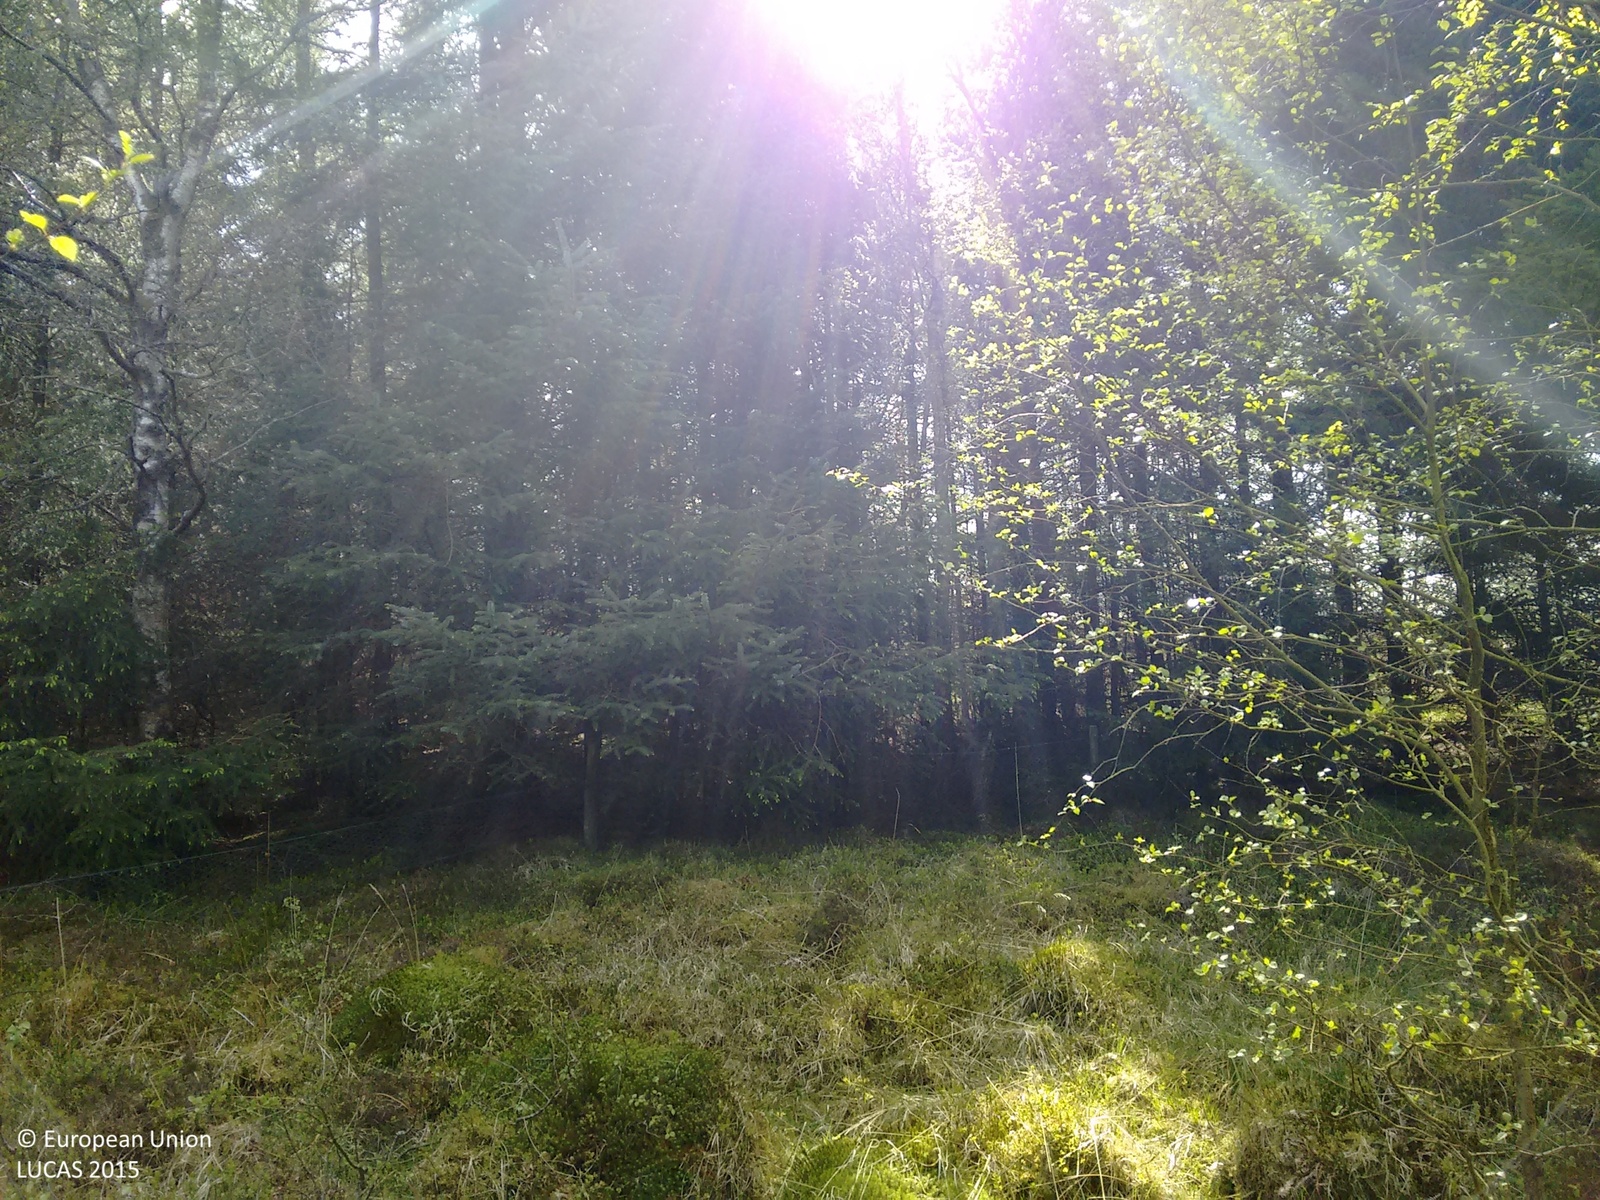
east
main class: Woodland
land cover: Broadleaved woodland
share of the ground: > 75 %
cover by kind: broadleaved forest trees 100 %
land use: Forestry
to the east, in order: Broadleaved woodland; Spruce dominated coniferous woodland; Fences; Broadleaved woodland; Grass margins; Tracks; Other bare soil; Rivers and streams; Other bare soil; Dry stone walls; Fences; Grassland without tree/shrub cover
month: May
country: GB
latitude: 56.1908
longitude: -3.9272
